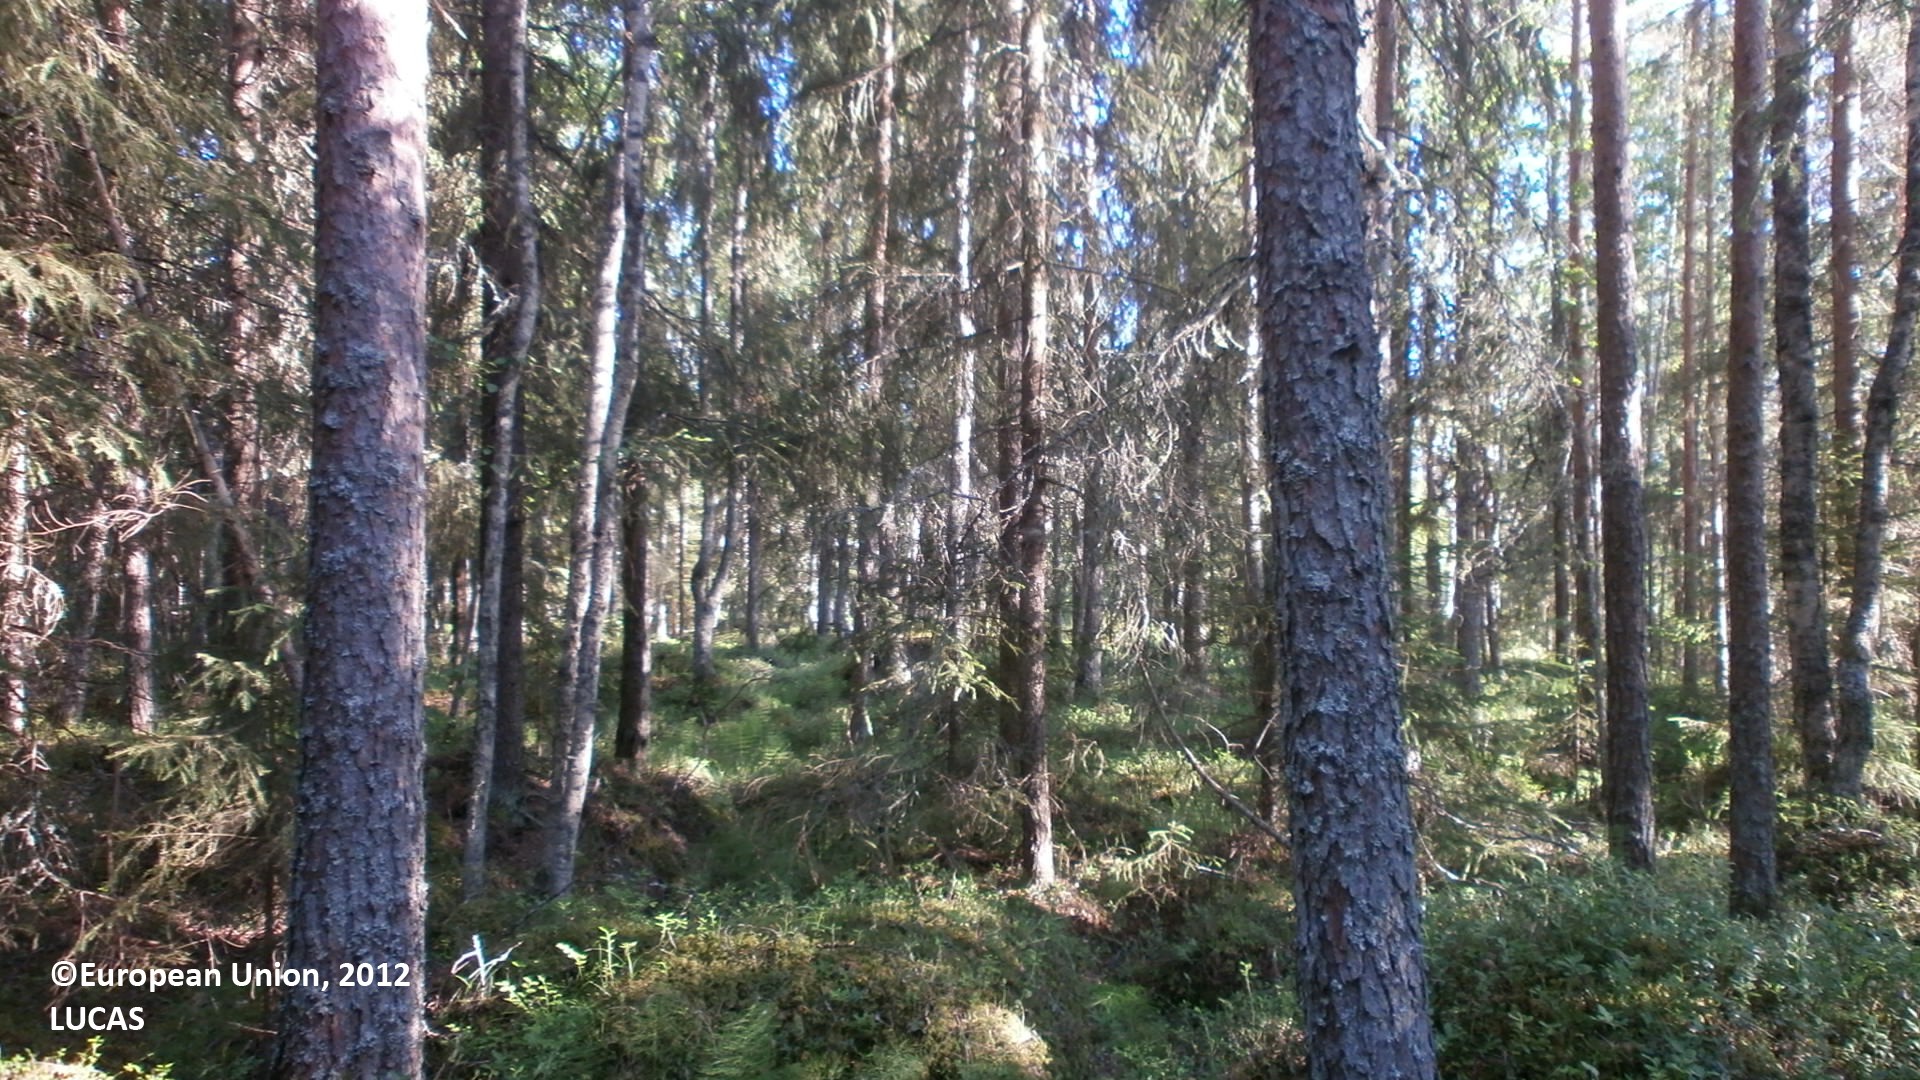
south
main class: Woodland
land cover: Spruce dominated mixed woodland
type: boreal forest
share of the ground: > 75 %
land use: Forestry
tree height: > 5 m
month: July
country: FI
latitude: 64.1541
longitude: 24.0657
